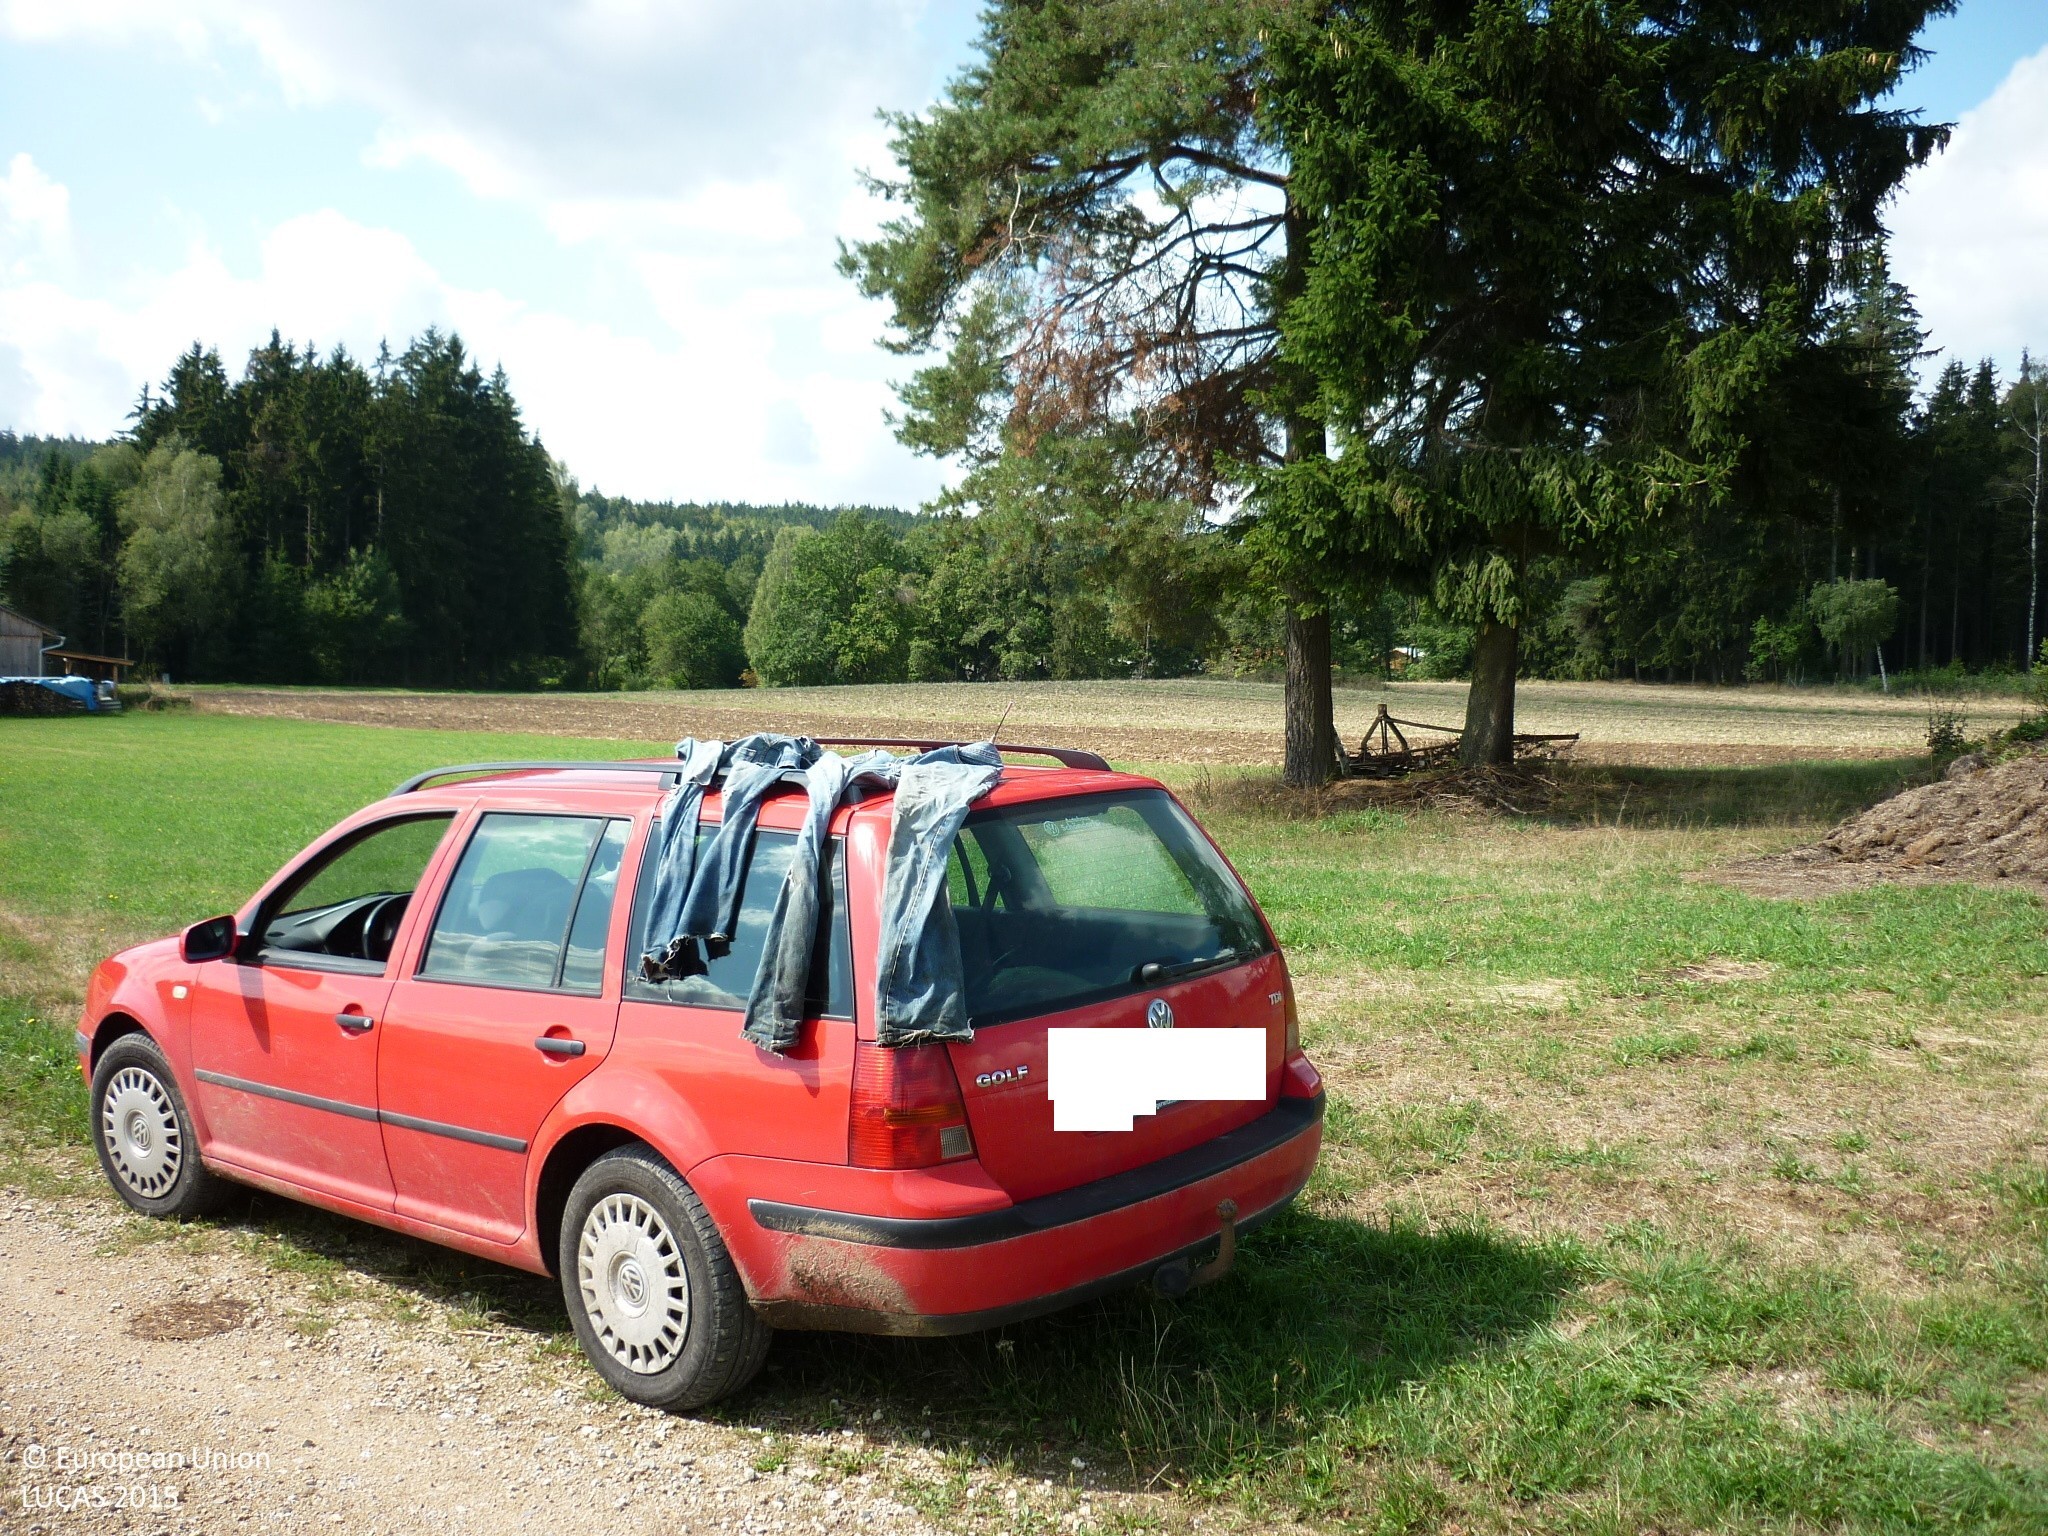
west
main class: Cropland
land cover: Rye
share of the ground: < 10 %
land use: Agriculture (excluding fallow land and kitchen gardens)
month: September
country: AT
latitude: 48.9710
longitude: 15.0978
